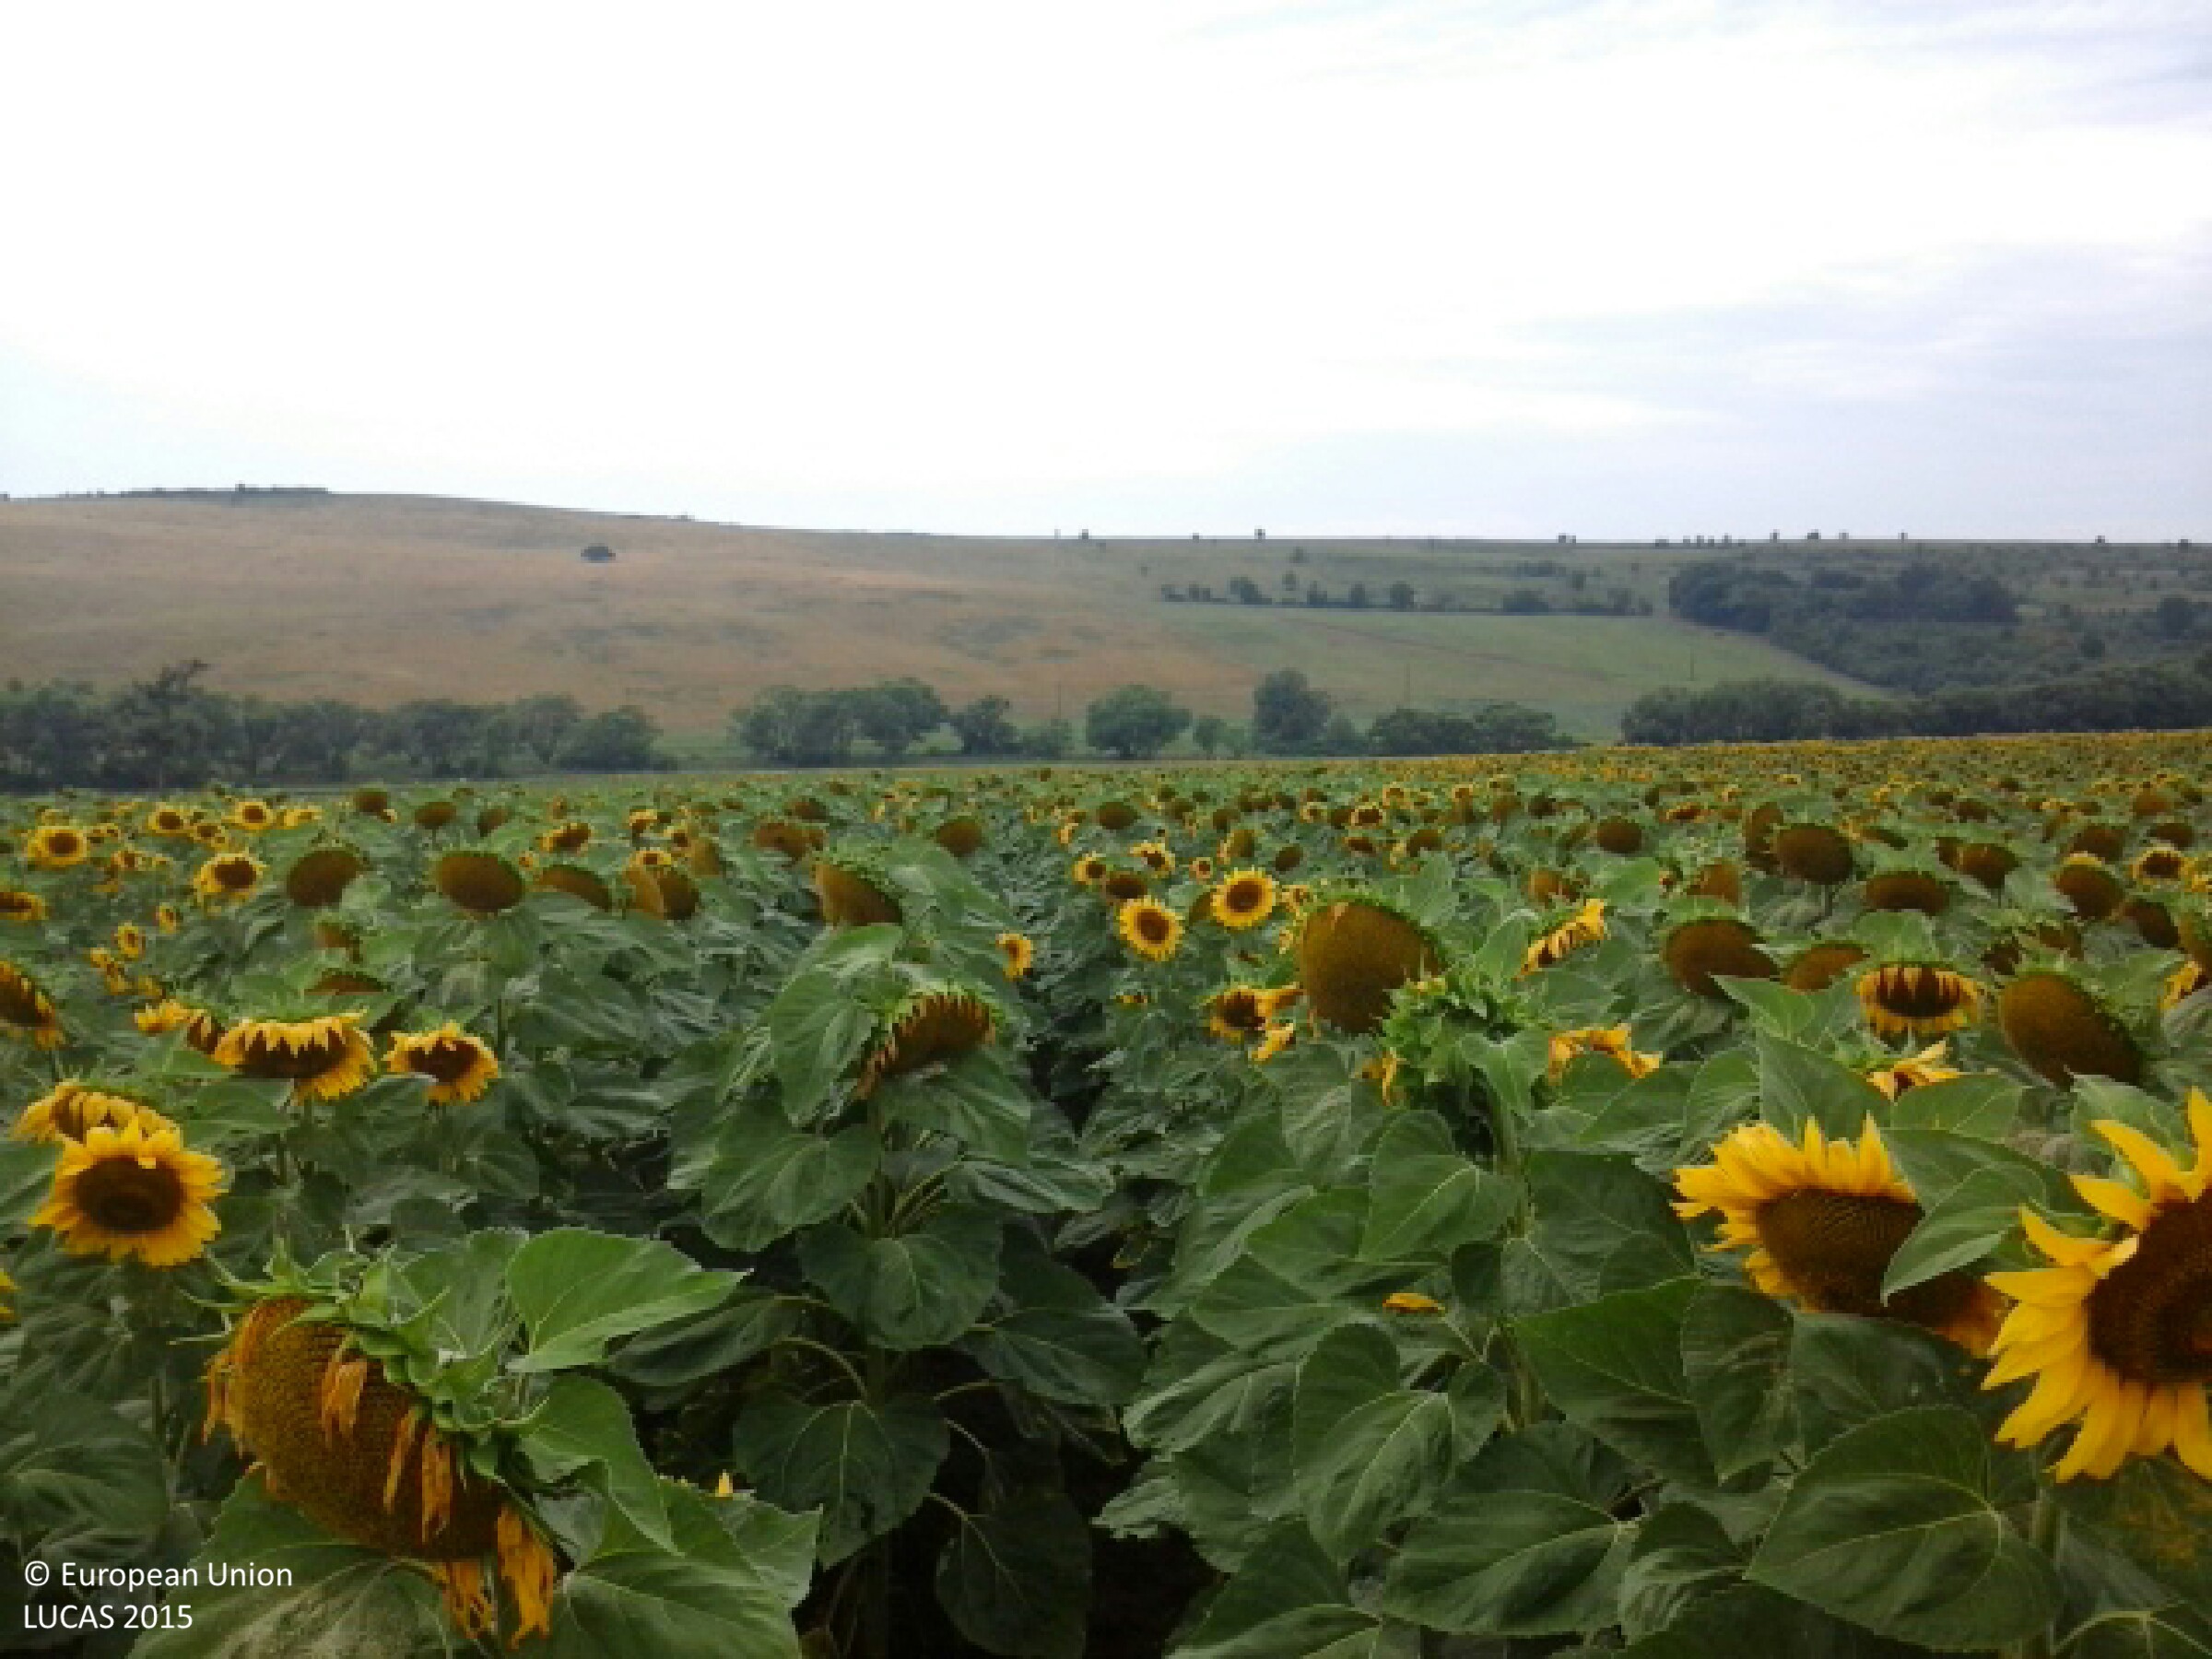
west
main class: Cropland
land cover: Sunflower
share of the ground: > 75 %
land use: Agriculture (excluding fallow land and kitchen gardens)
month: July
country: HU
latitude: 48.3653
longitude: 20.9596
